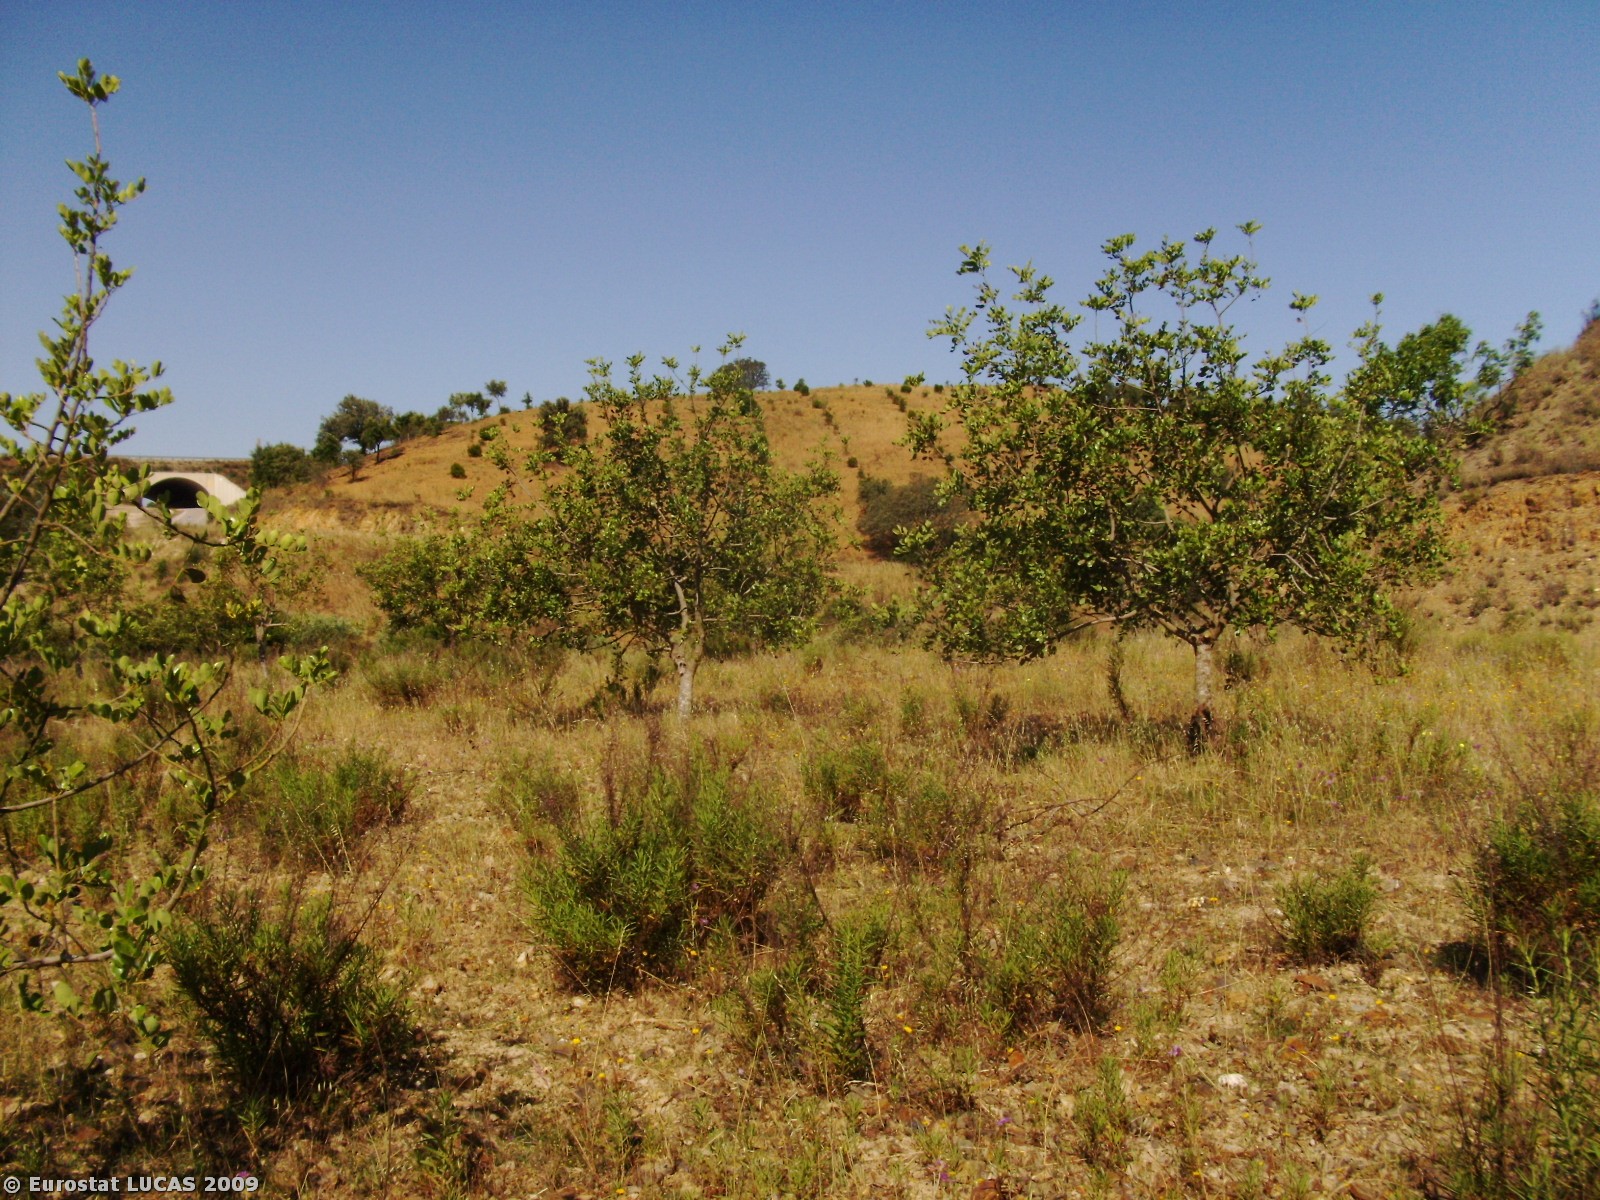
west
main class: Cropland
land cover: Permanent industrial crops
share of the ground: 10 - 25 %
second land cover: Spontaneously vegetated surfaces
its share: 25 - 50 %
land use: Agriculture (excluding fallow land and kitchen gardens)
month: May
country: PT
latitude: 37.2789
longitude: -8.2589
